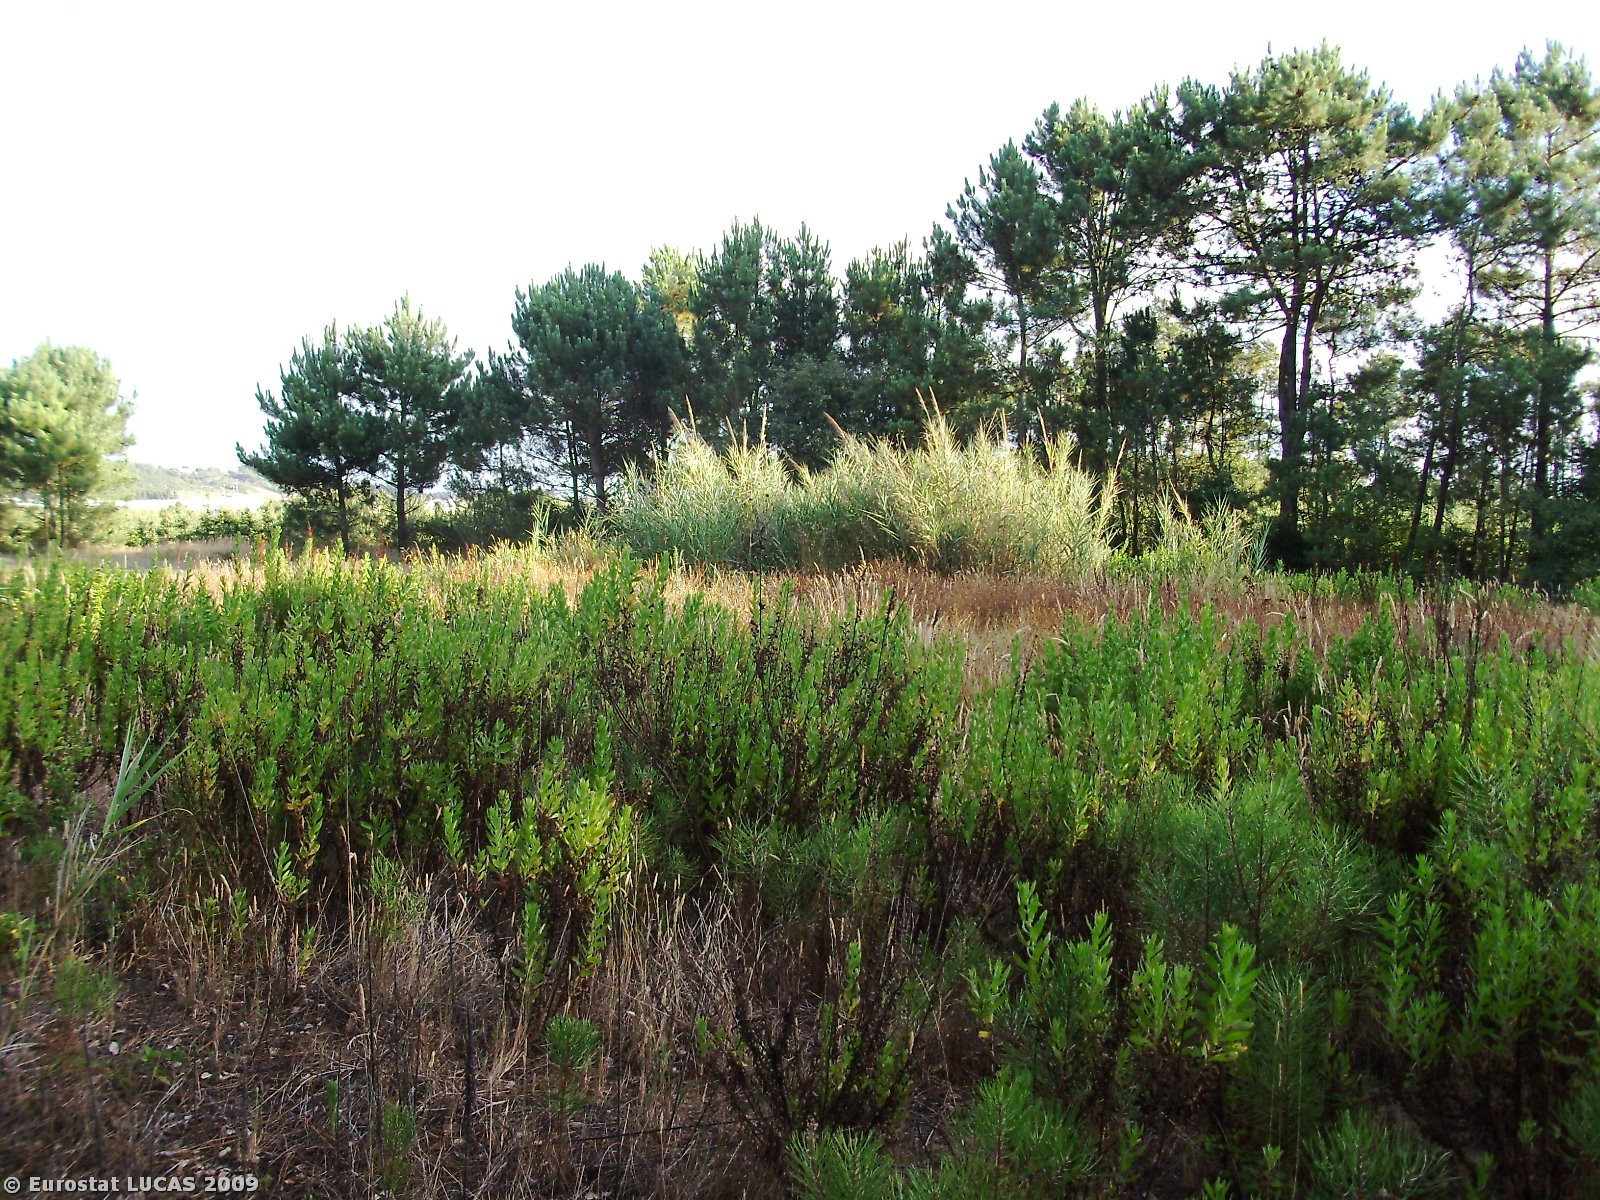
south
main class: Woodland
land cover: Coniferous woodland
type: coniferous forest of the mediterranean region
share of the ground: 25 - 50 %
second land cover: Shrubland with sparse tree cover
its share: 50 - 75 %
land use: Forestry
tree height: > 5 m
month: July
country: PT
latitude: 39.4392
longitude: -9.1328
